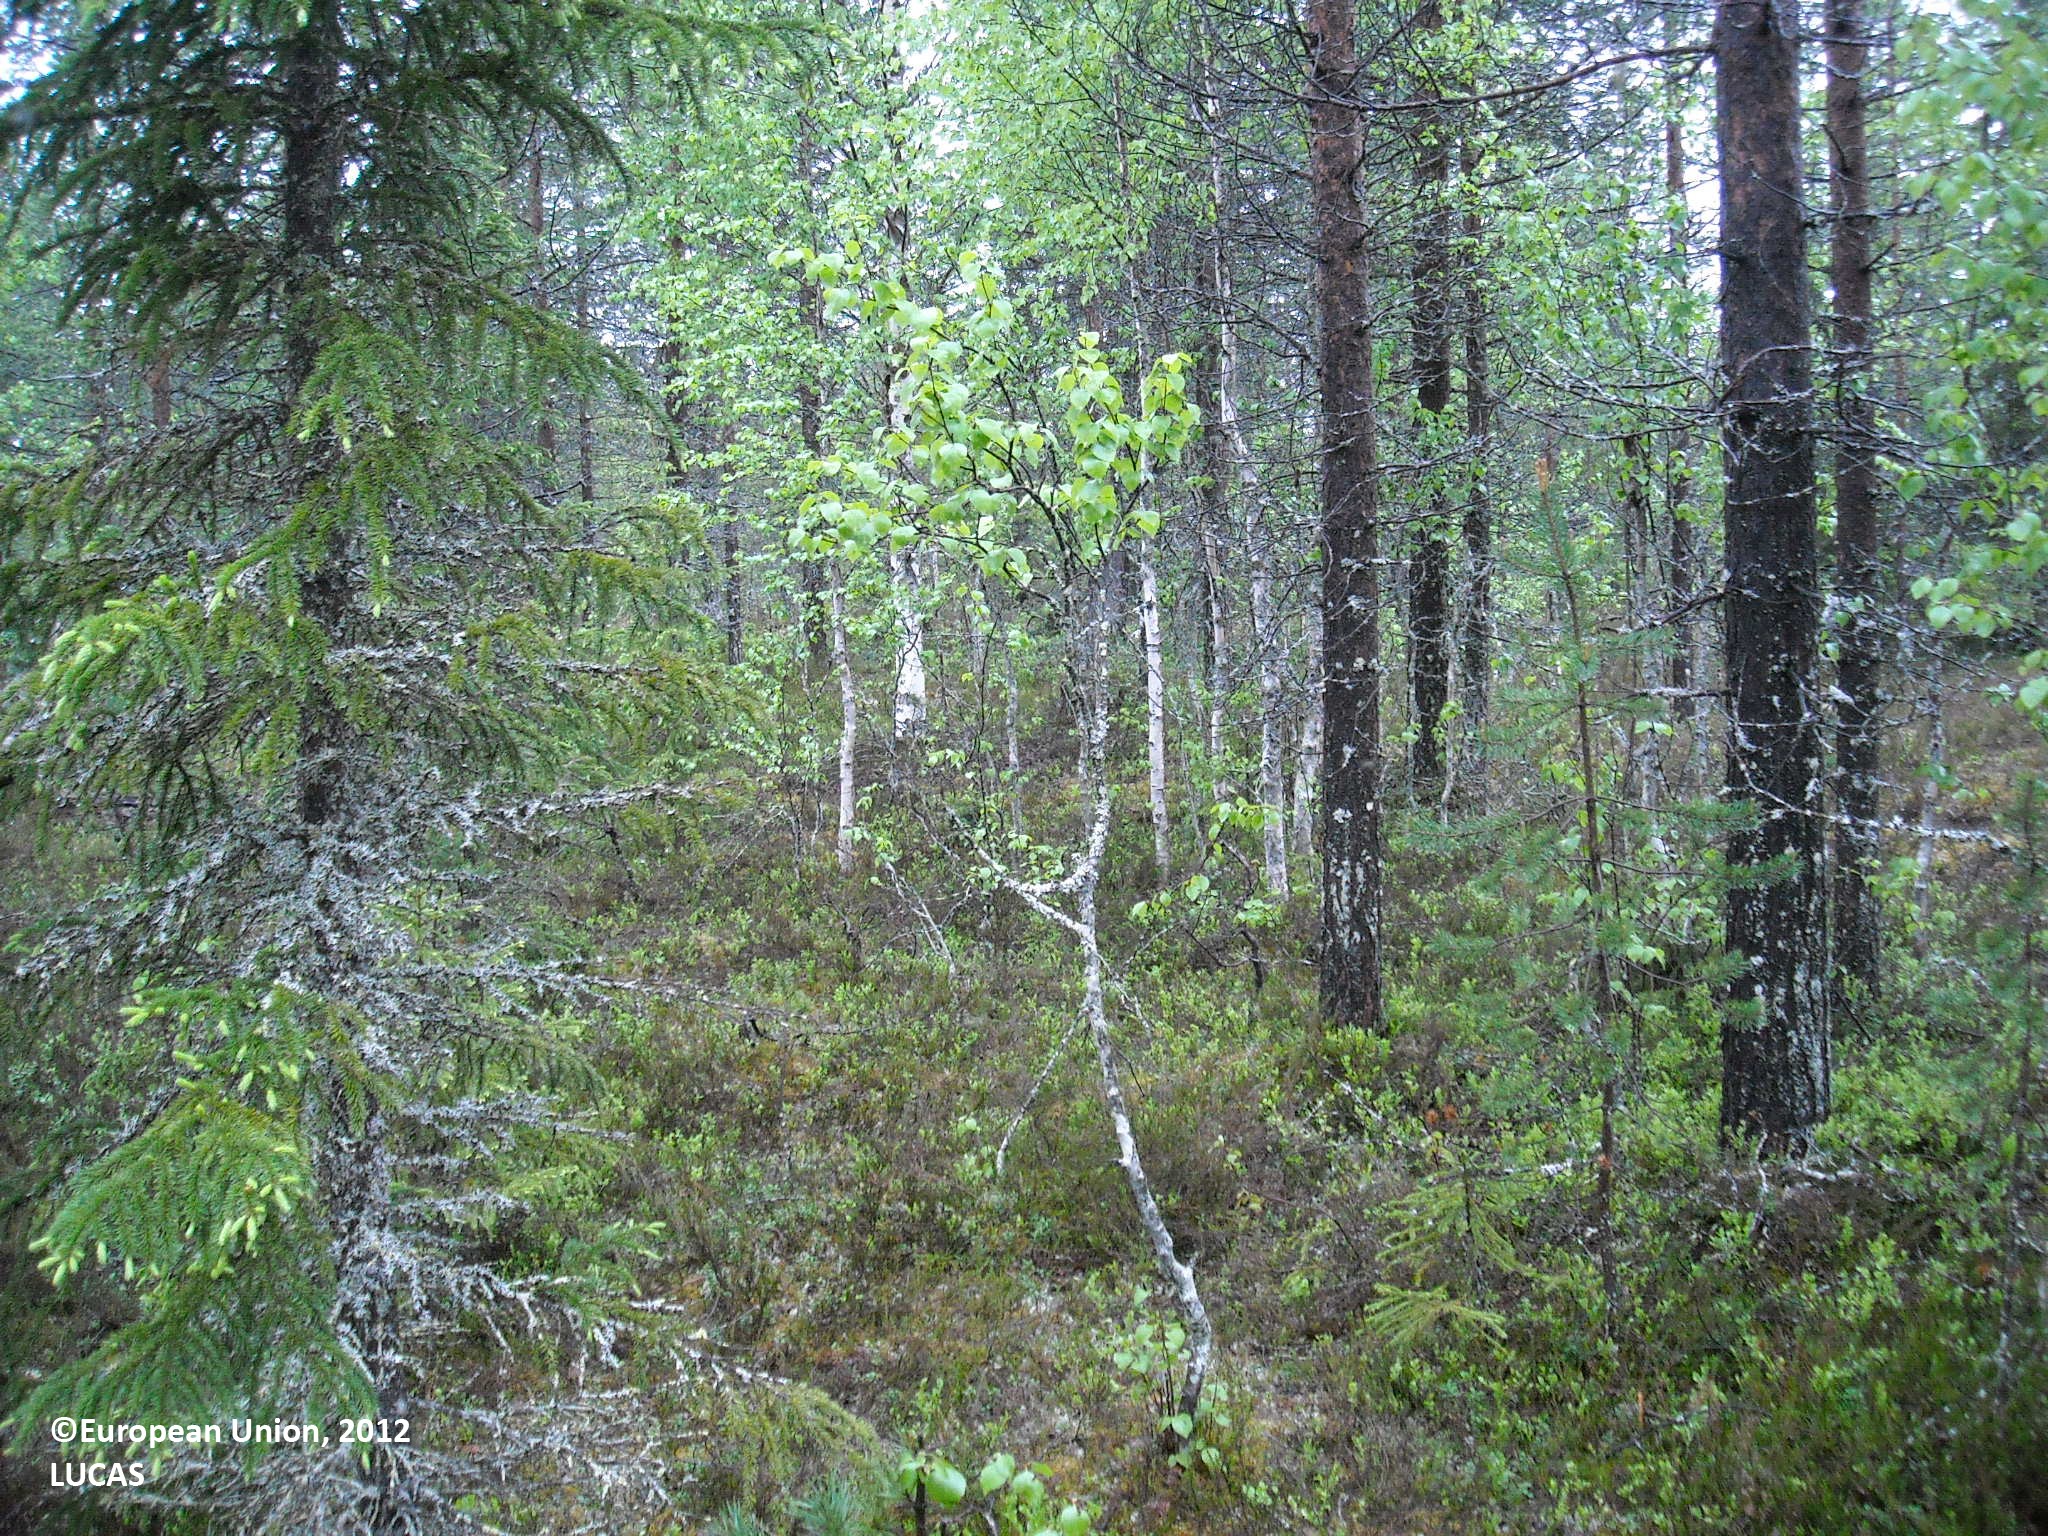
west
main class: Woodland
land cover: Other coniferous woodland
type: boreal forest
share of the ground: > 75 %
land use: Forestry
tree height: > 5 m
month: June
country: FI
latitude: 65.6255
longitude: 27.8808
